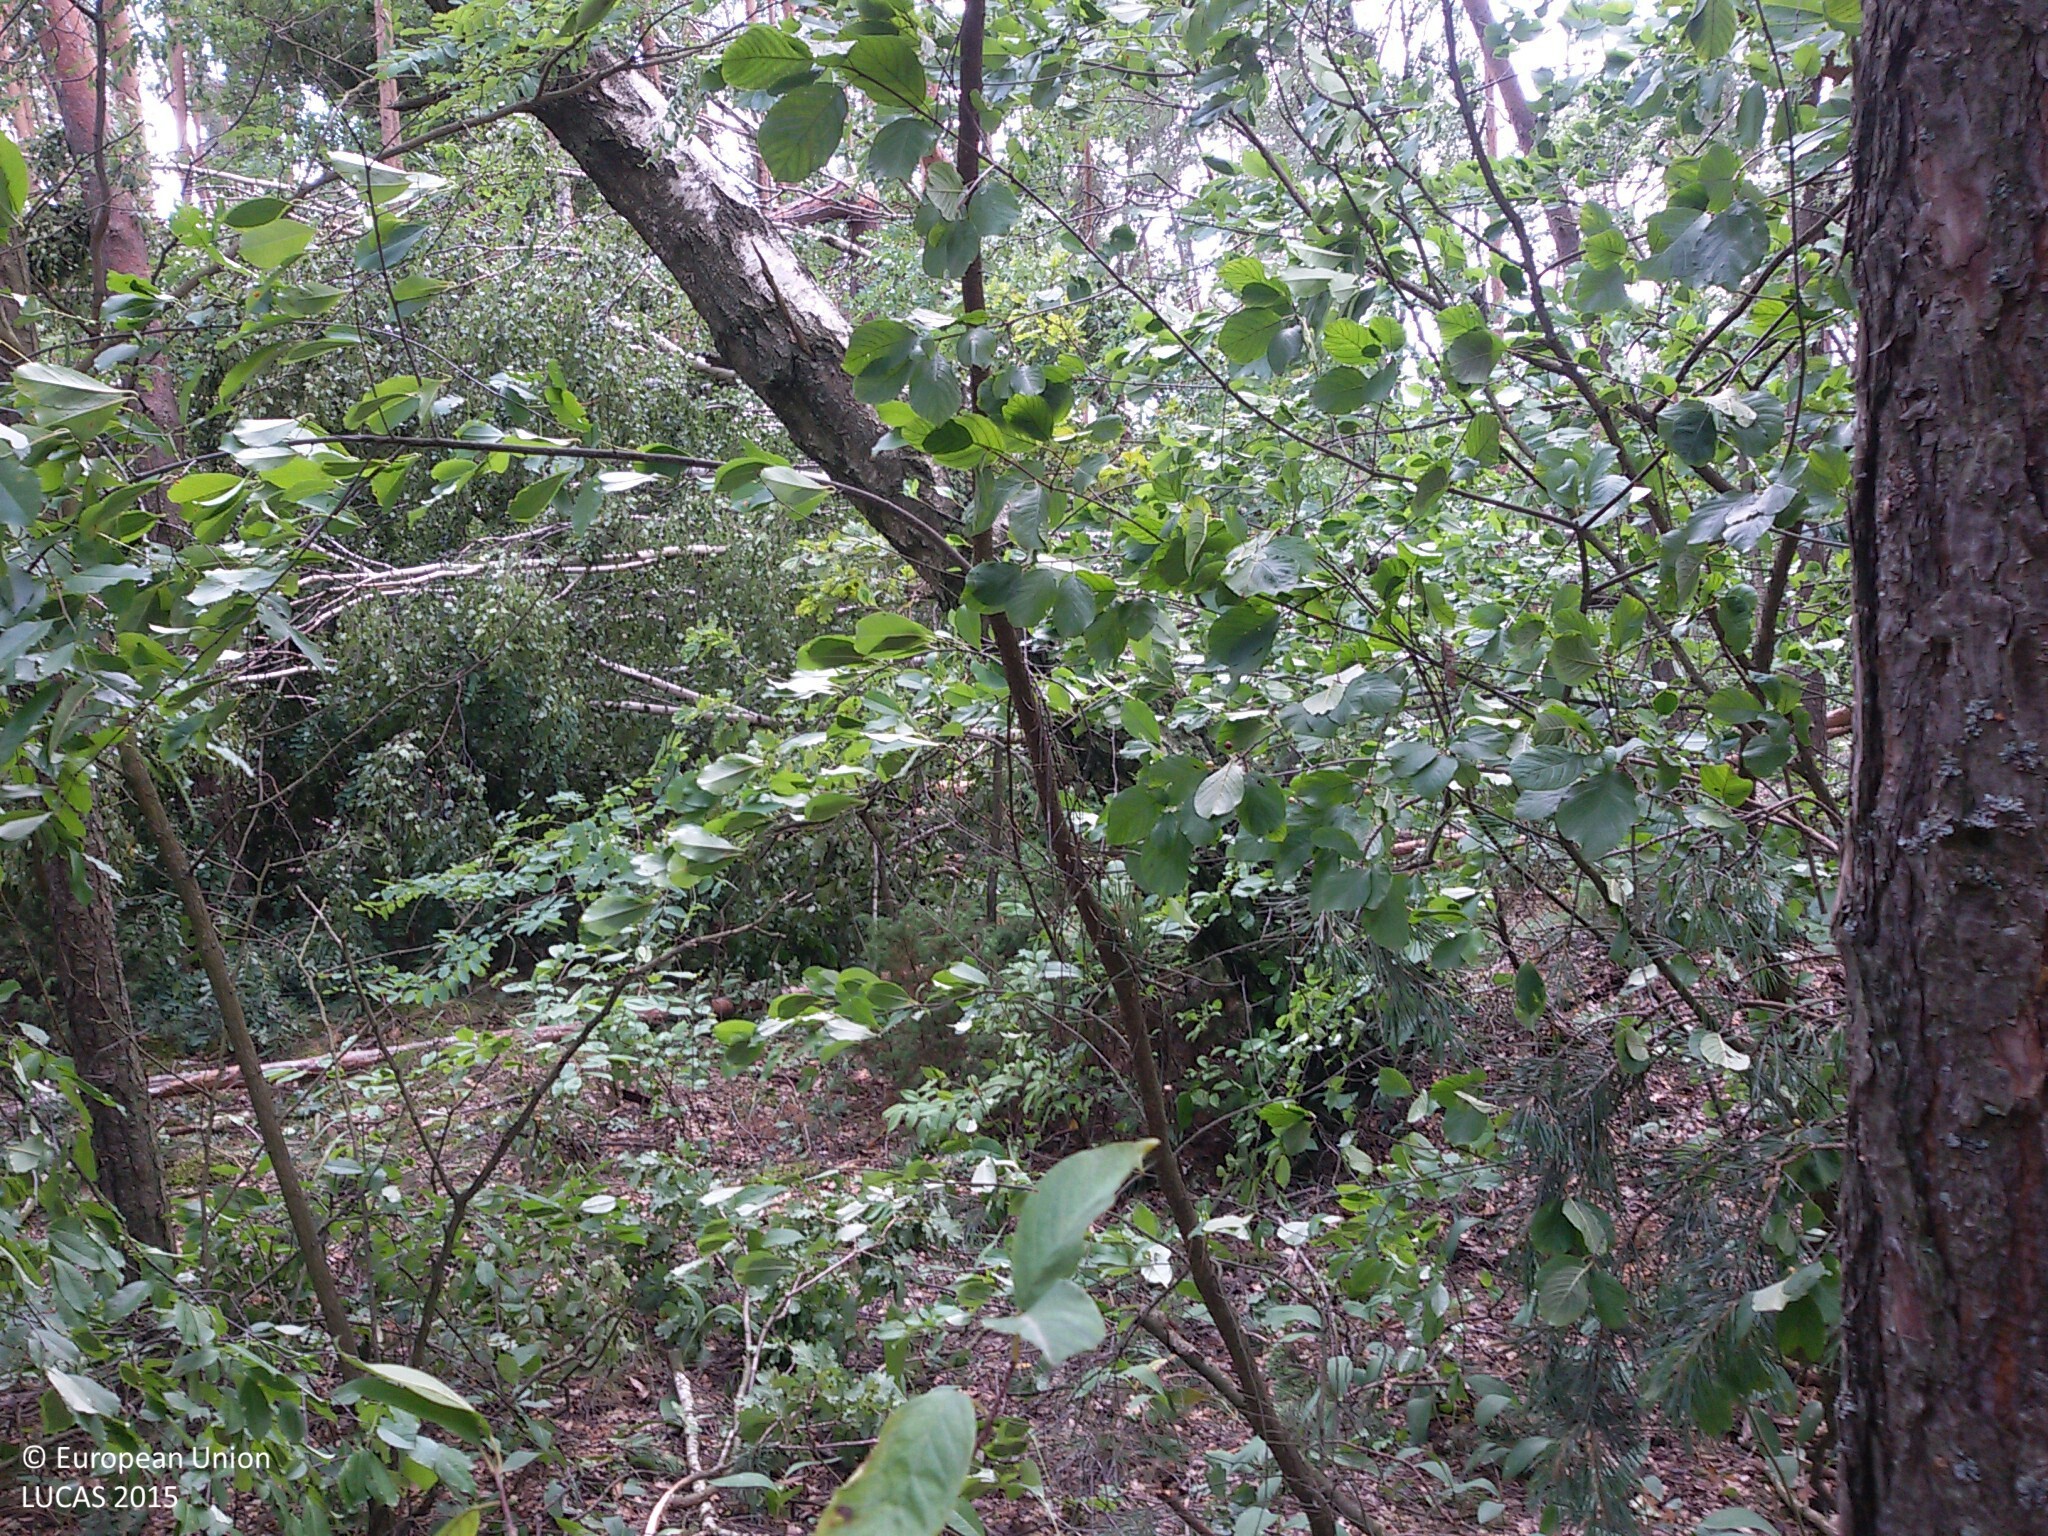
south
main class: Woodland
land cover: Pine dominated mixed woodland
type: hemiboreal forest and nemoral coniferous forest and mixed broadleaved-coniferous forest
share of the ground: 50 - 75 %
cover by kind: coniferous forest trees 45 %, broadleaved forest trees 25 %, shrubs 10 %, herbaceous plants 10 %, lichens and mosses 5 %, unconsolidated bare surface 5 %
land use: Forestry
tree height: > 5 m
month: July
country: PL
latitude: 52.9929
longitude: 21.3563
